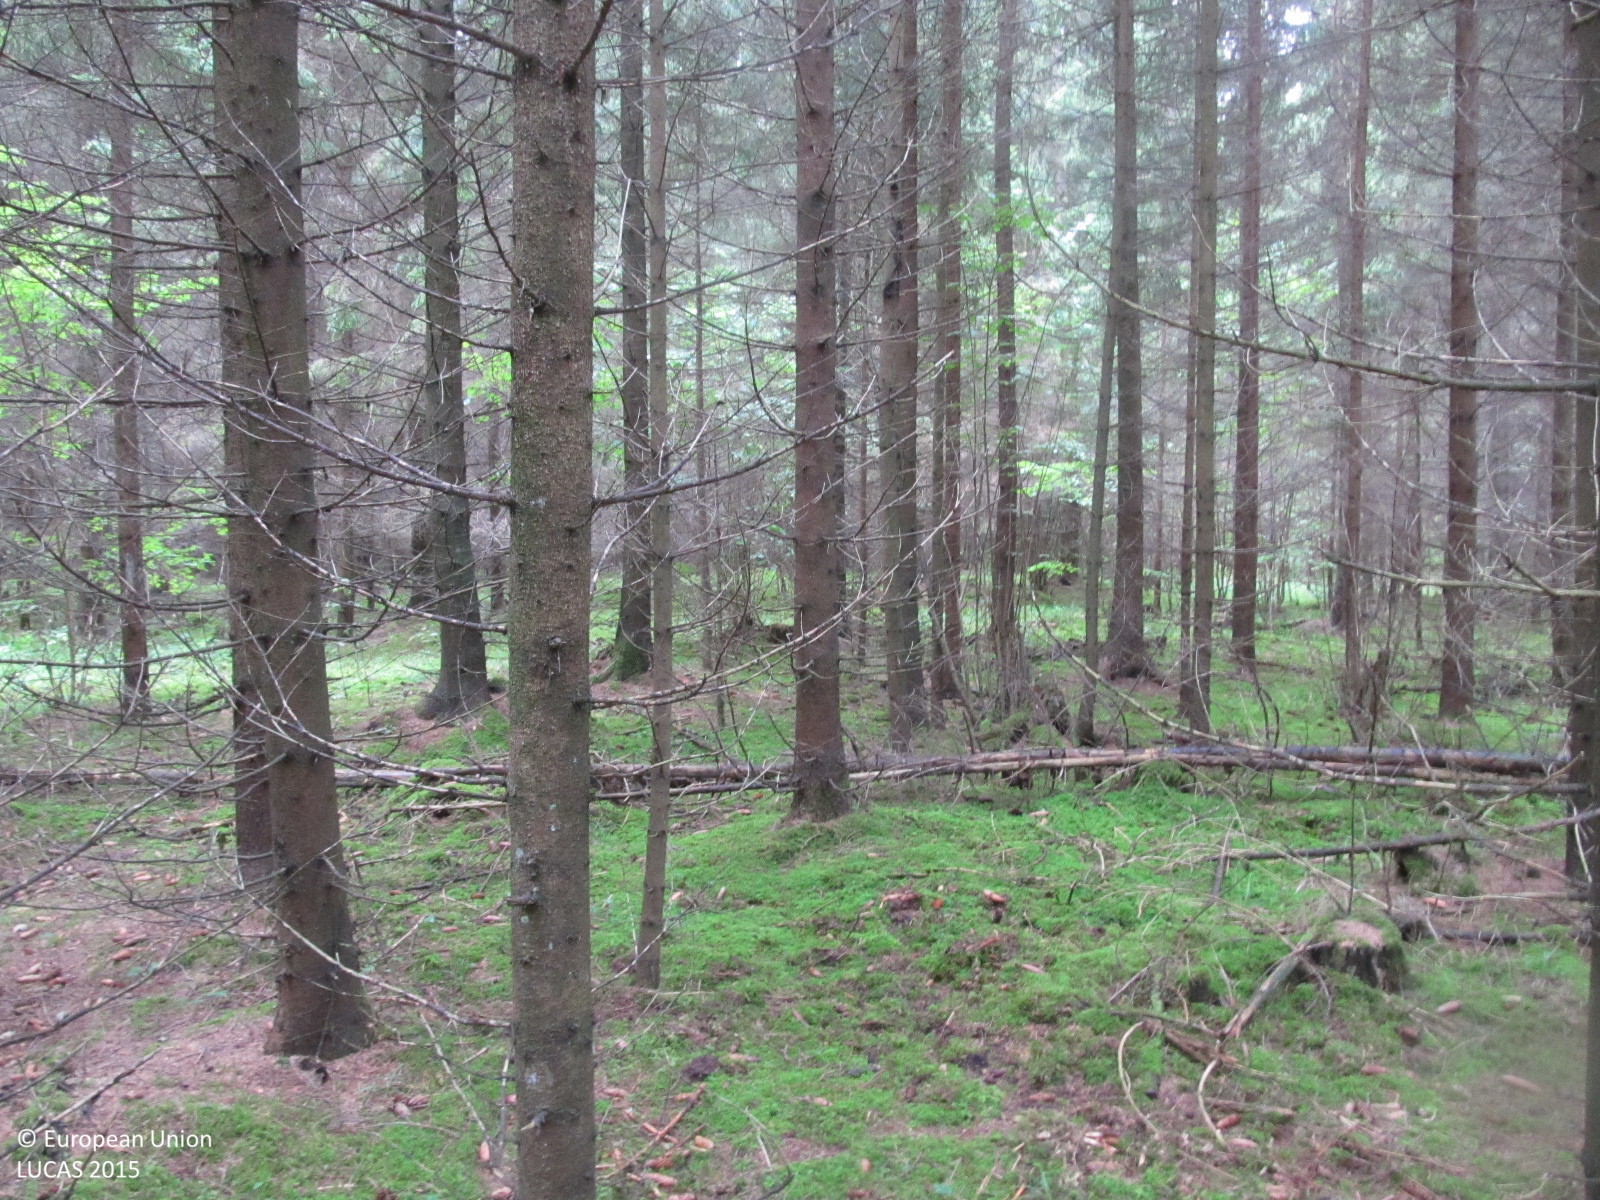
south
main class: Woodland
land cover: Spruce dominated coniferous woodland
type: hemiboreal forest and nemoral coniferous forest and mixed broadleaved-coniferous forest
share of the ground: > 75 %
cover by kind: coniferous forest trees 80 %, lichens and mosses 15 %, herbaceous plants 5 %
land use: Forestry
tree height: > 5 m
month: September
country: LT
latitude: 56.0648
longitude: 23.2262
